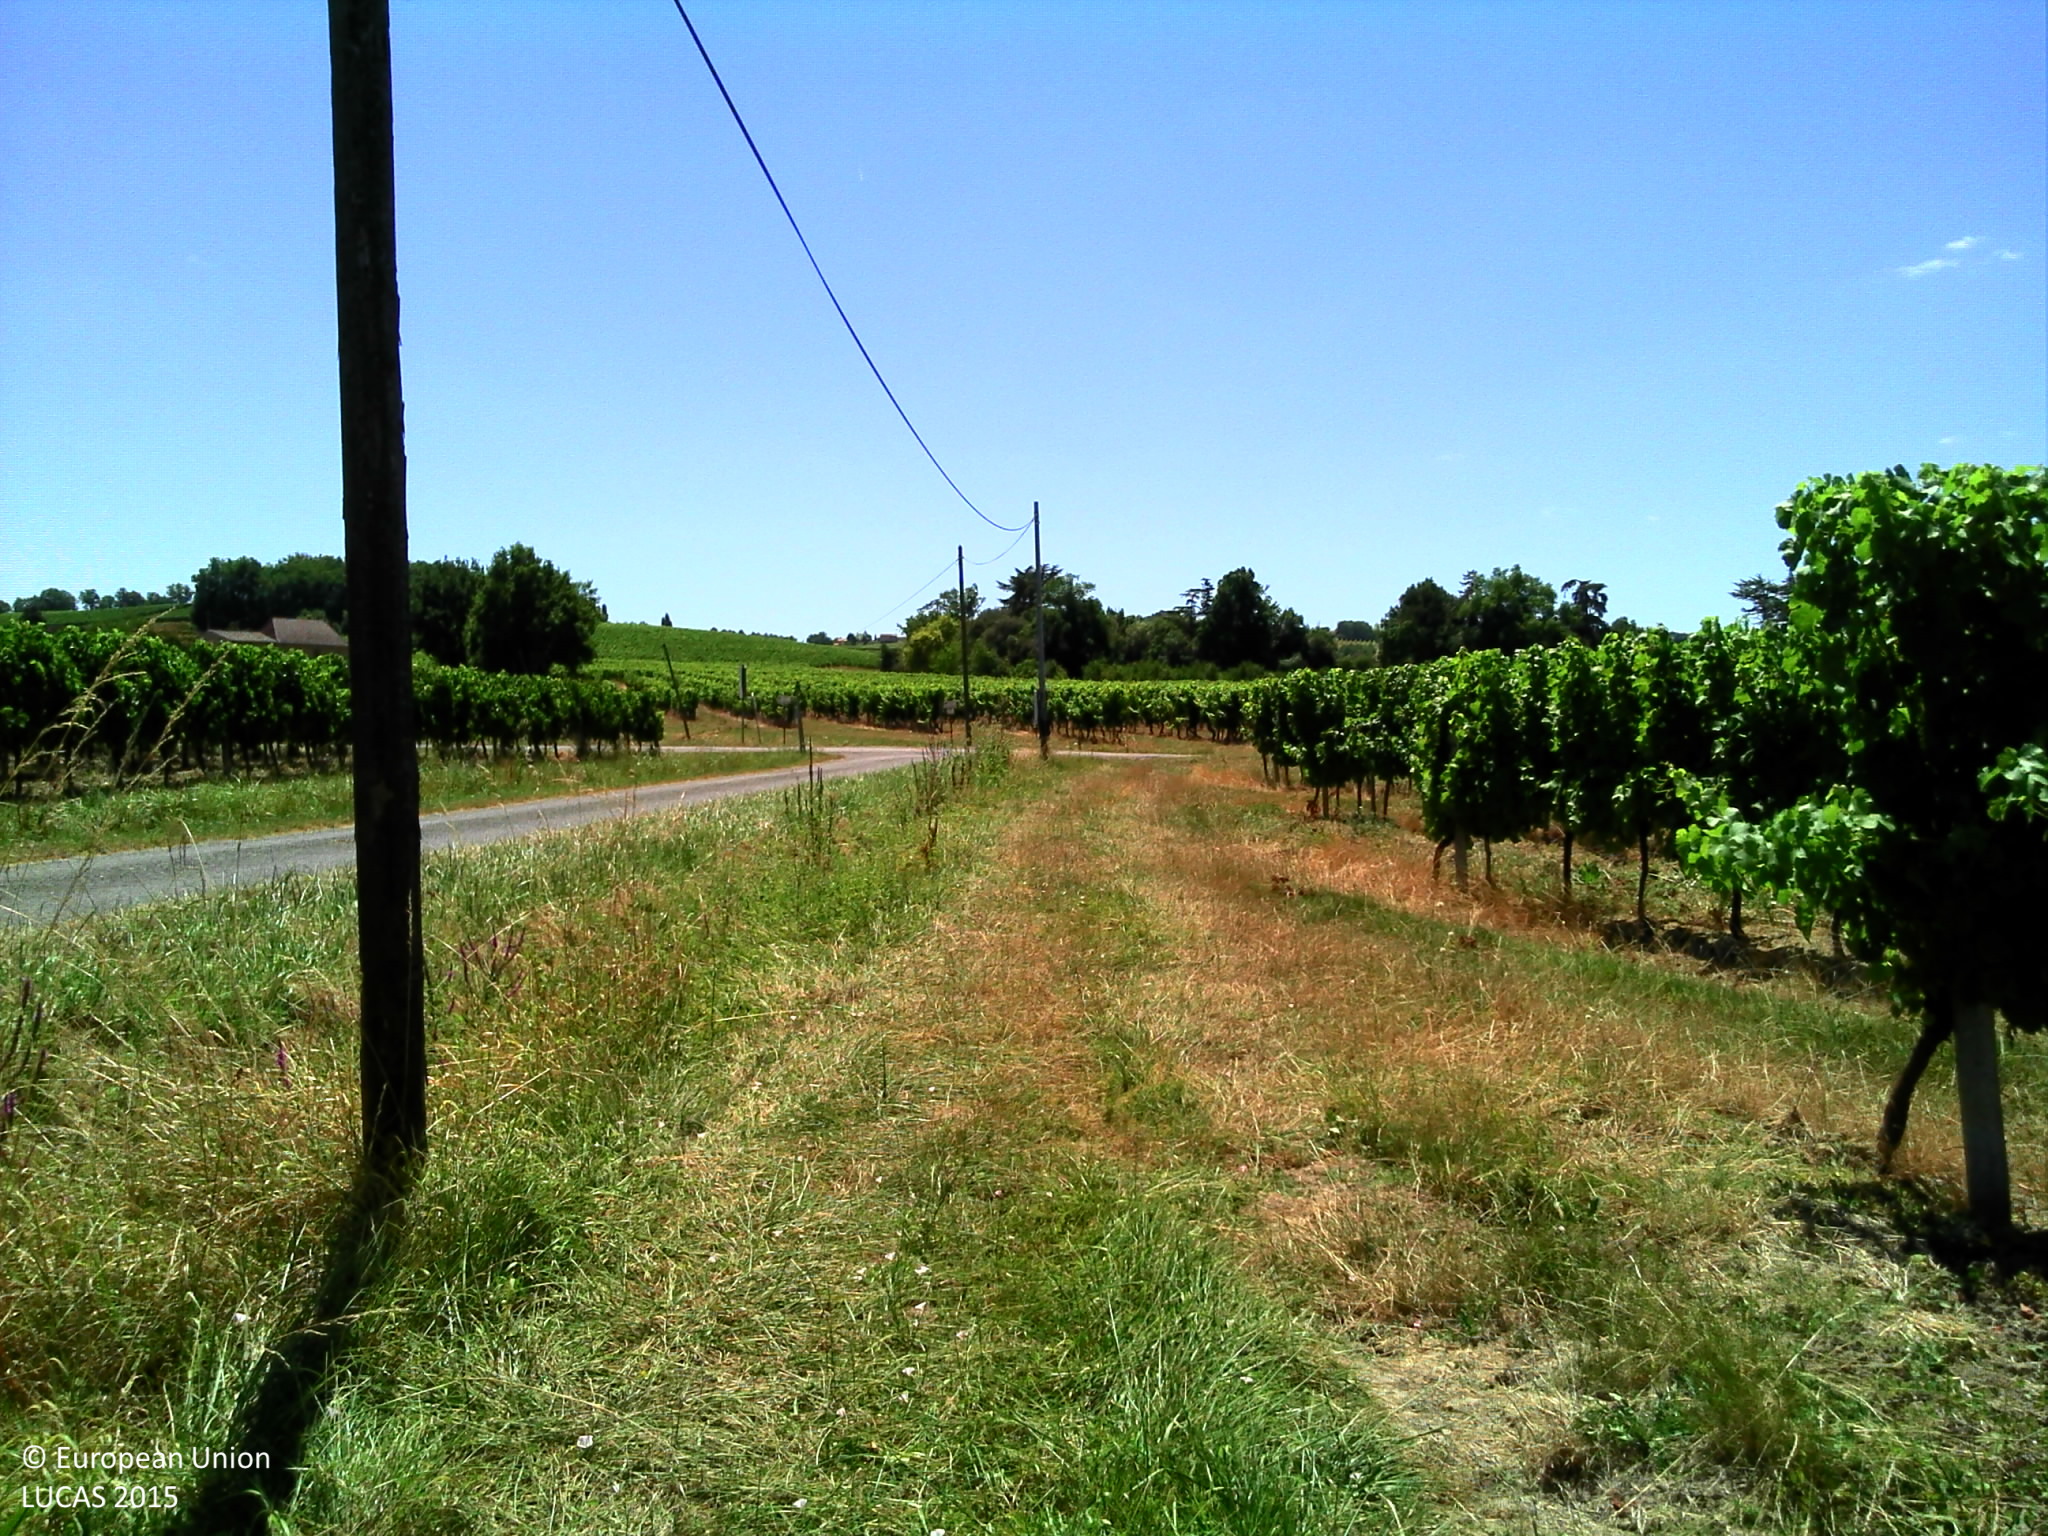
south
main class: Cropland
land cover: Vineyards
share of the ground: 25 - 50 %
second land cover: Grassland without tree/shrub cover
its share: > 75 %
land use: Agriculture (excluding fallow land and kitchen gardens)
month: July
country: FR
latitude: 44.8049
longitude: 0.5210
